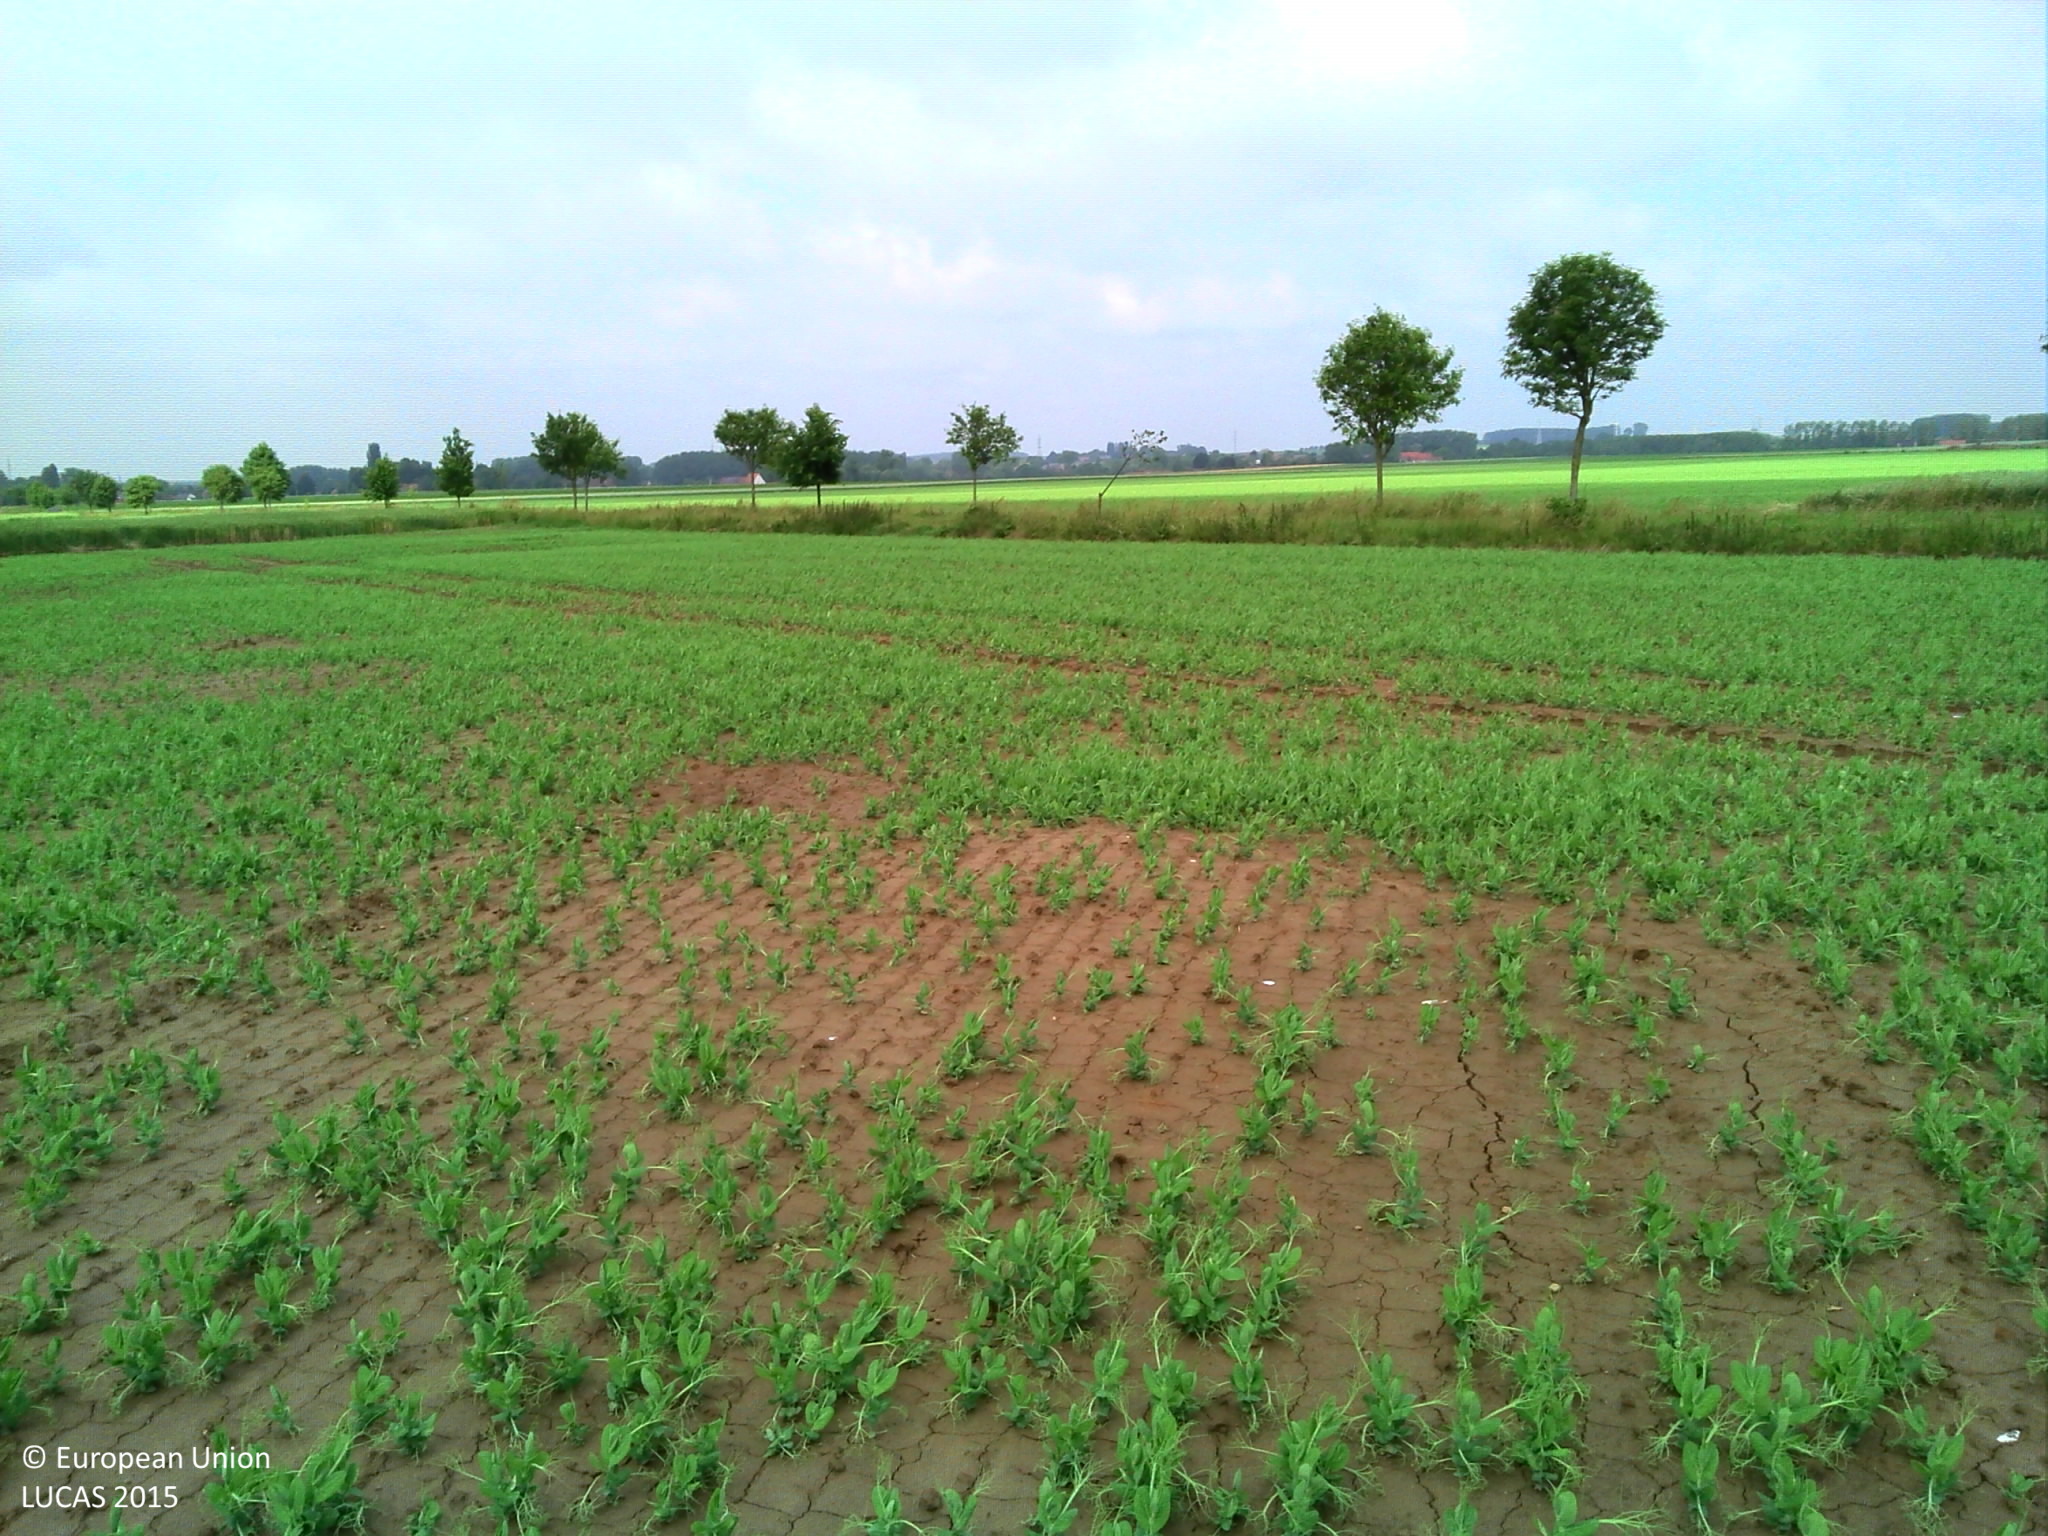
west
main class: Cropland
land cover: Dry pulses
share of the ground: 50 - 75 %
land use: Agriculture (excluding fallow land and kitchen gardens)
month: June
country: BE
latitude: 50.5743
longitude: 3.7945
